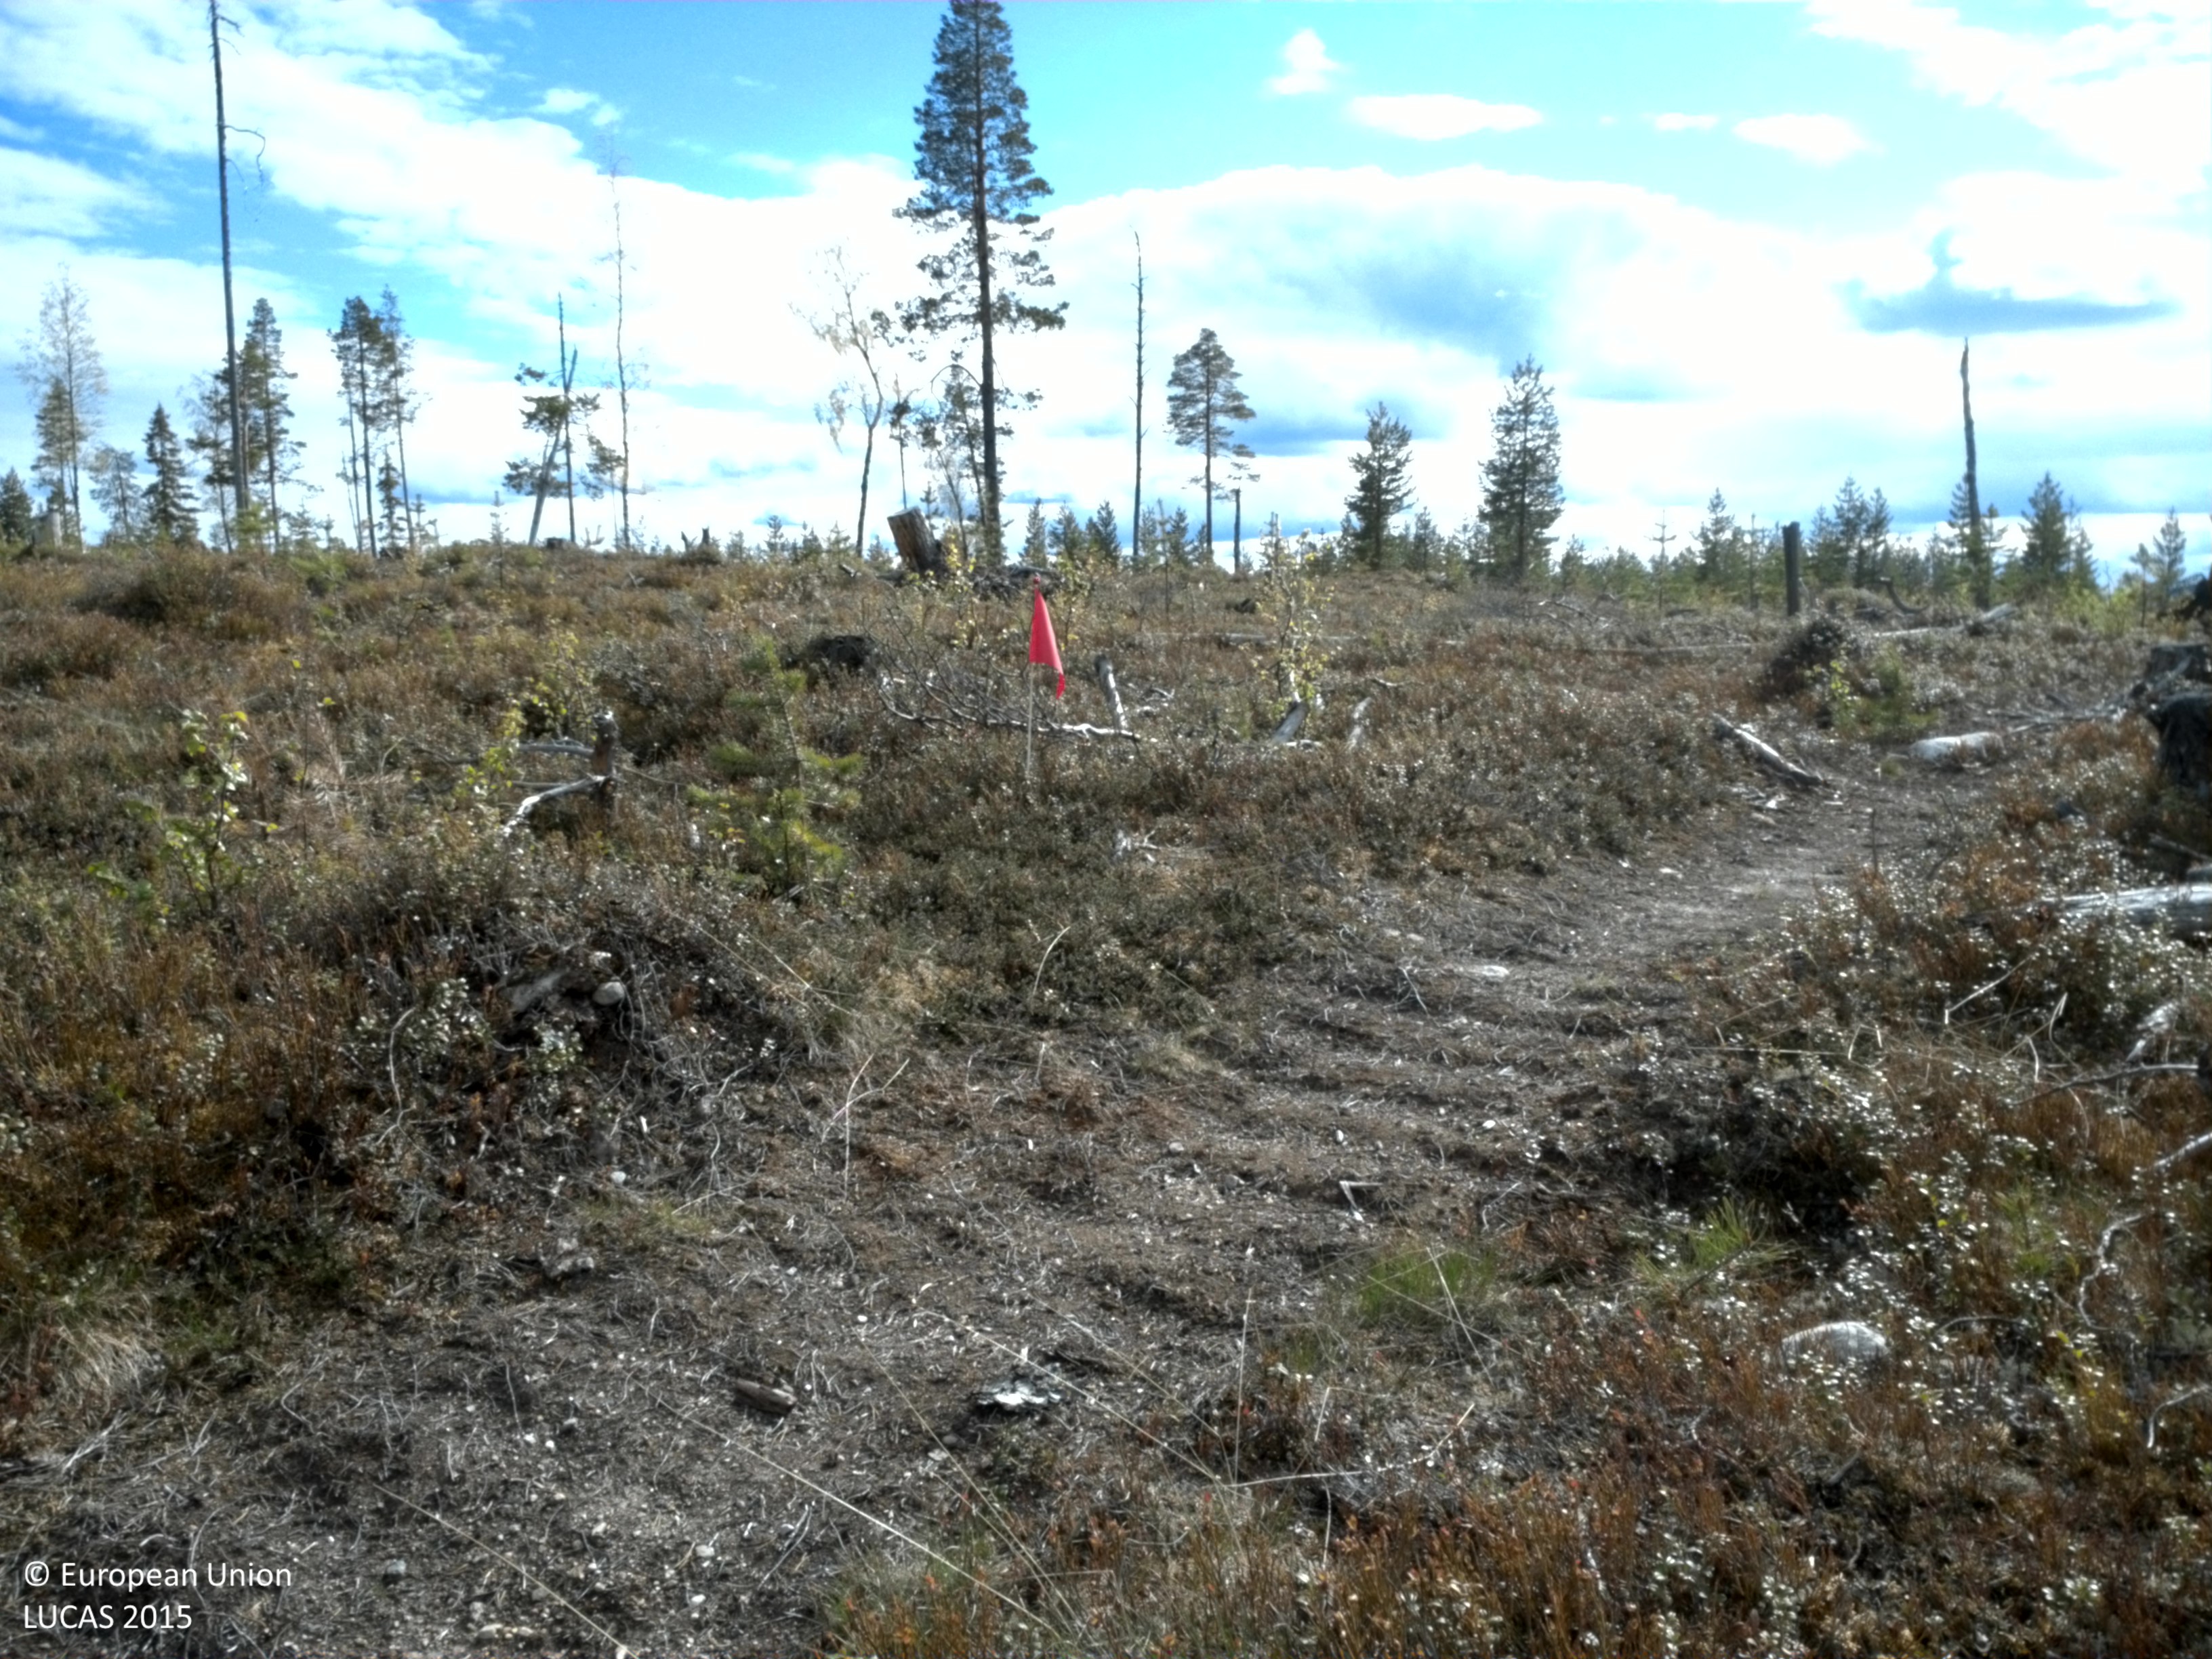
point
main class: Shrubland
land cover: Shrubland with sparse tree cover
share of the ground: > 75 %
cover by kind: shrubs 90 %, coniferous forest trees 5 %, herbaceous plants 5 %
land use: Forestry
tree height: < 5 m
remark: Clear cut
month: June
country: SE
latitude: 66.2122
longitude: 18.7745
